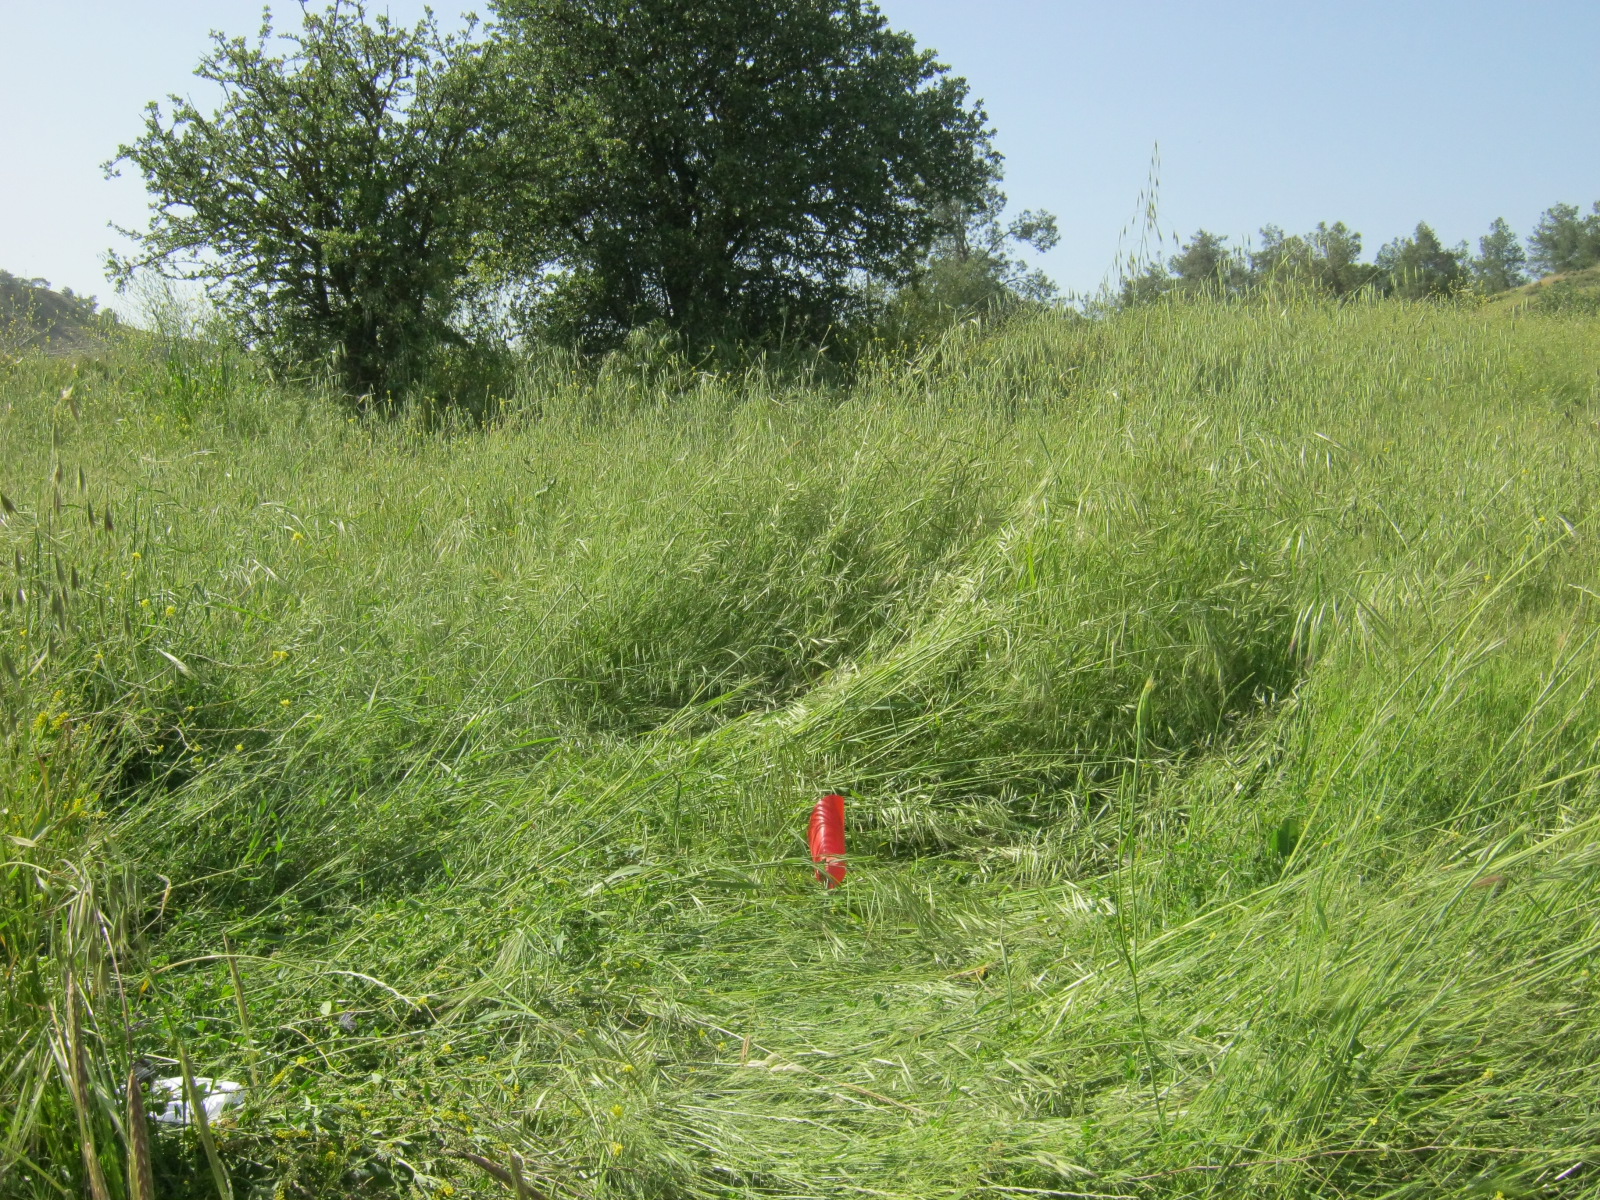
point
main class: Grassland
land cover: Grassland with sparse tree/shrub cover
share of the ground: > 75 %
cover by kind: herbaceous plants 95 %, broadleaved forest trees 5 %
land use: Semi-natural and natural areas not in use
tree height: > 5 m
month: April
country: CY
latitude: 35.0162
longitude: 33.2301
